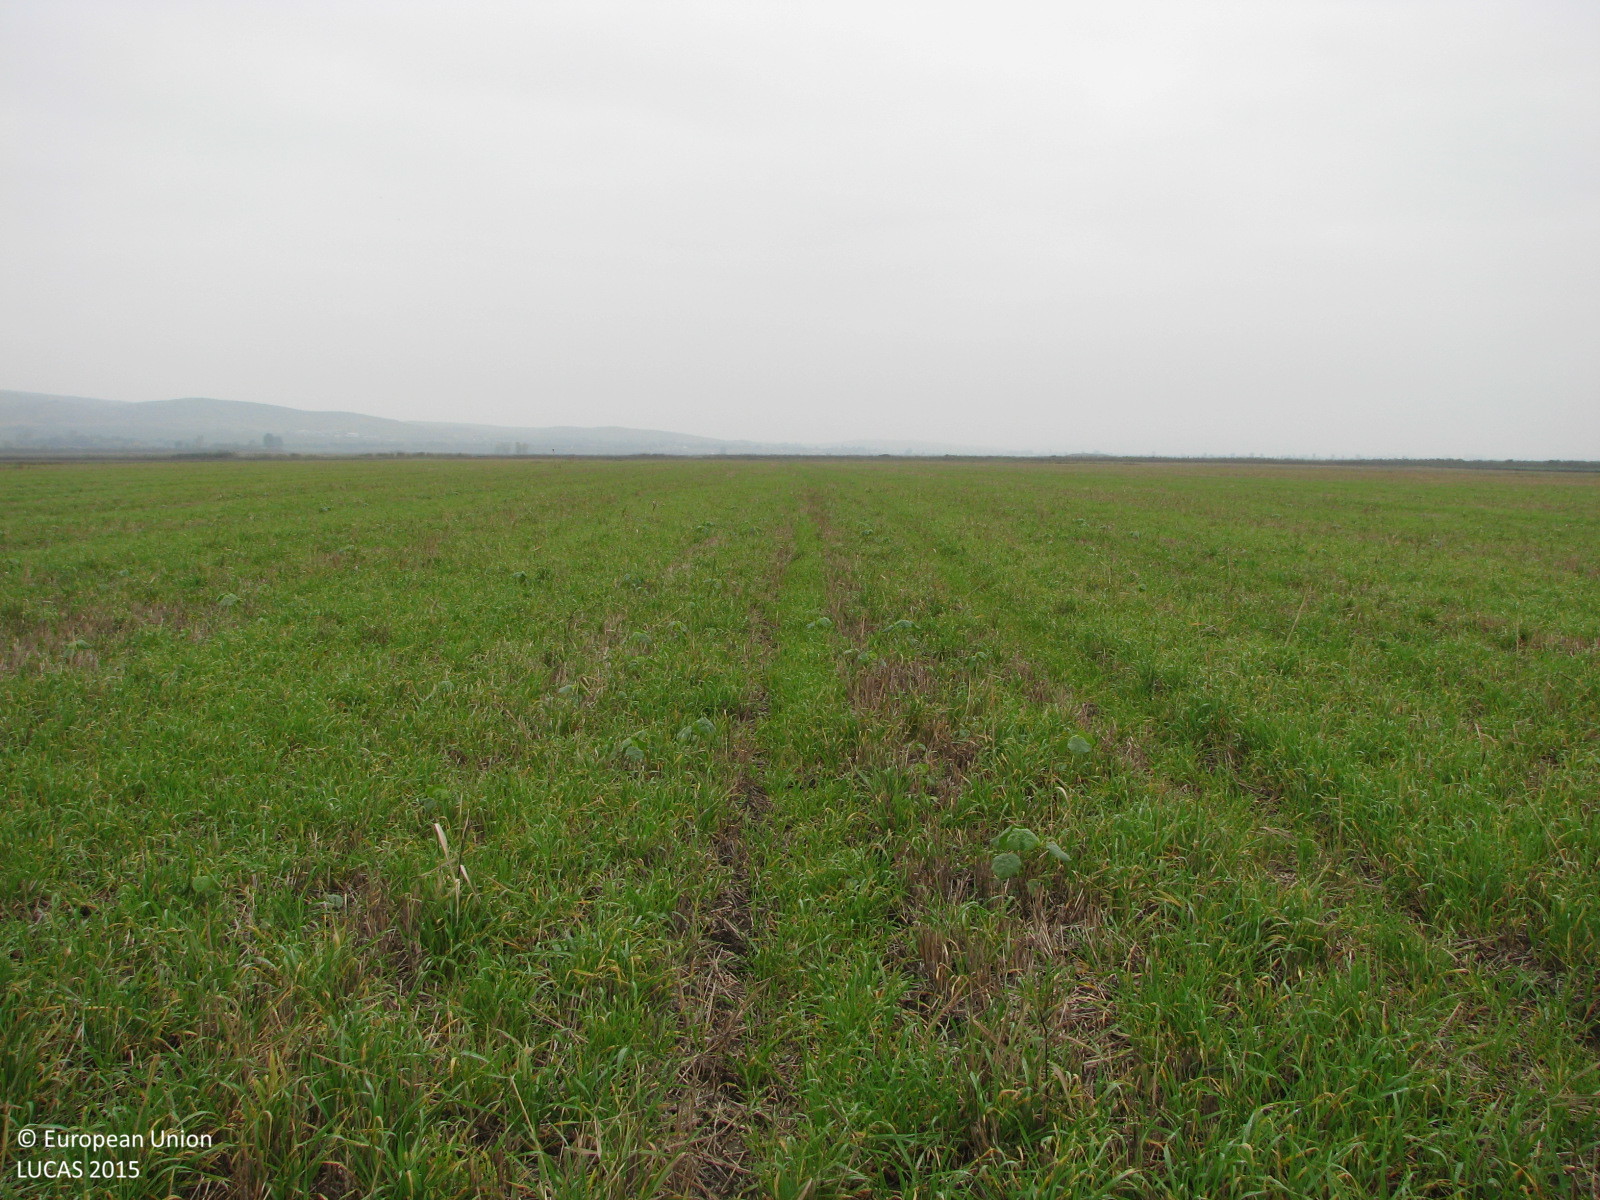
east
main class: Cropland
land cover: Common wheat
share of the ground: > 75 %
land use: Agriculture (excluding fallow land and kitchen gardens)
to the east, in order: Common wheat
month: October
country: BG
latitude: 42.6287
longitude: 26.7441
